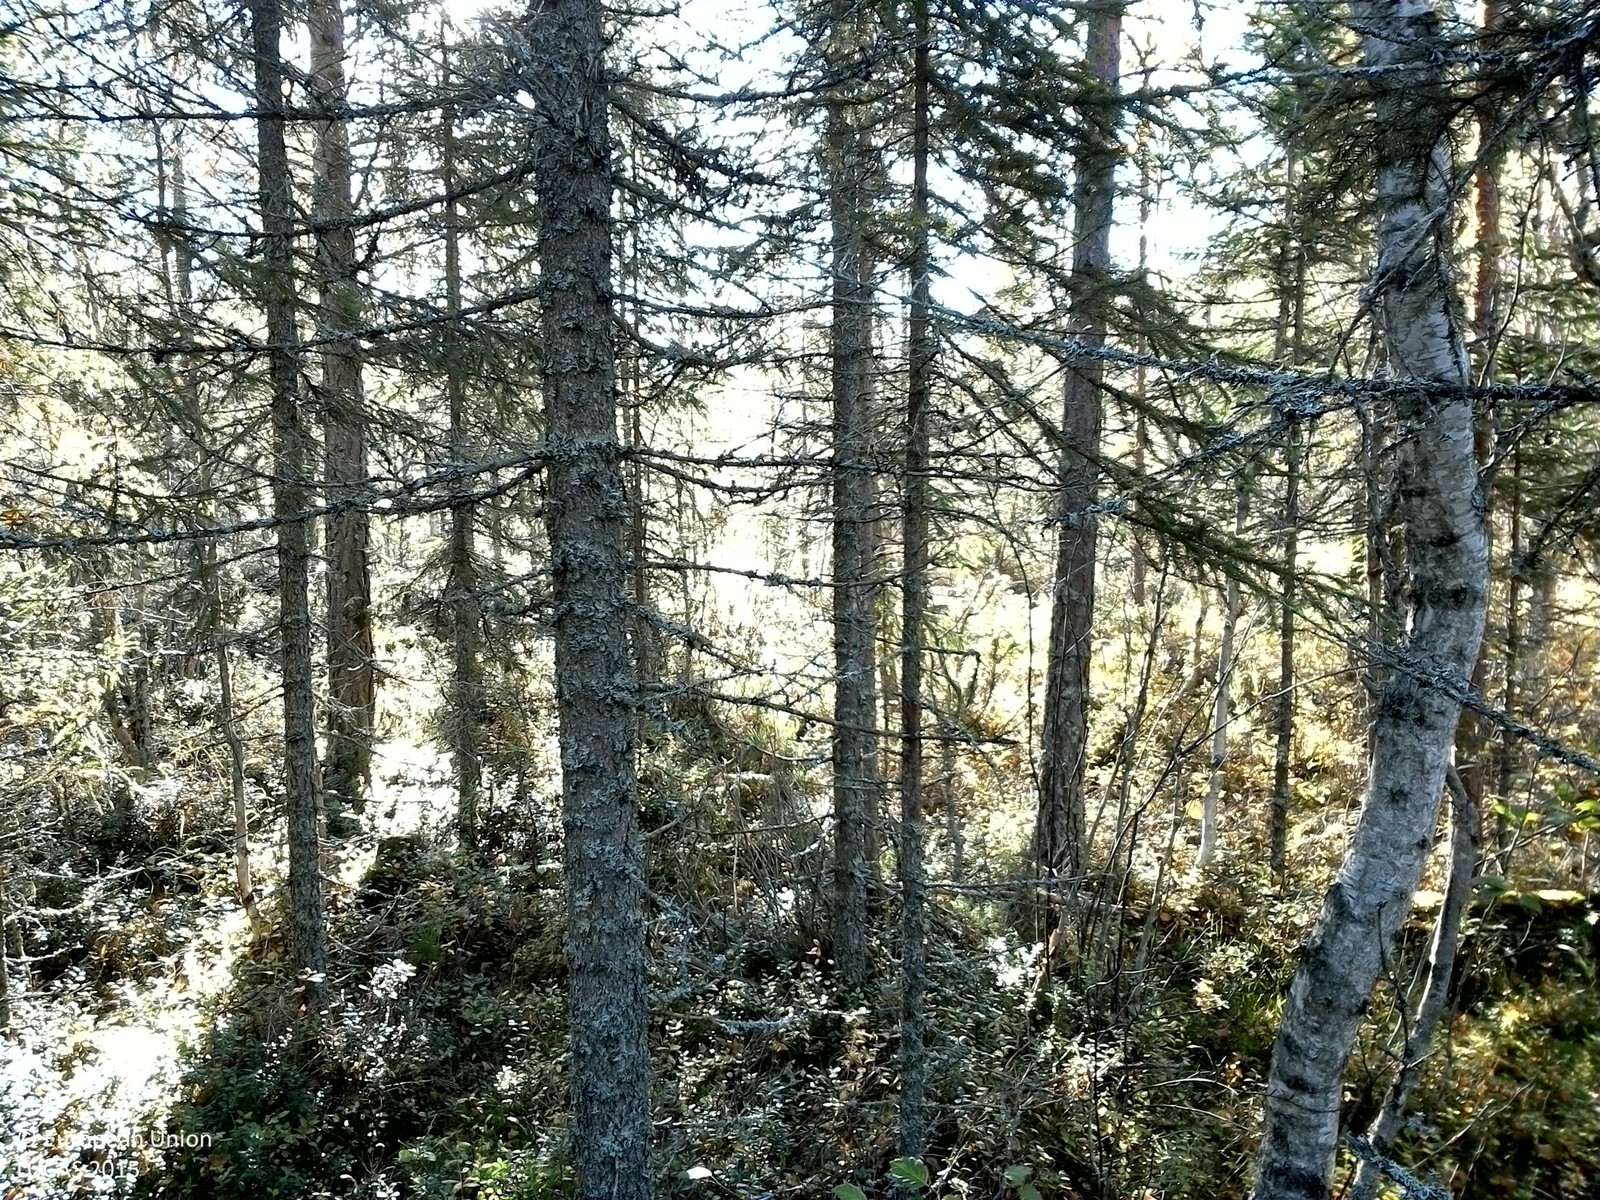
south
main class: Woodland
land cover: Other mixed woodland
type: boreal forest
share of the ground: 50 - 75 %
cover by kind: coniferous forest trees 50 %, broadleaved forest trees 20 %, shrubs 20 %, lichens and mosses 10 %
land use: Forestry
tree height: > 5 m
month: October
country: SE
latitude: 61.3728
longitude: 15.0179
